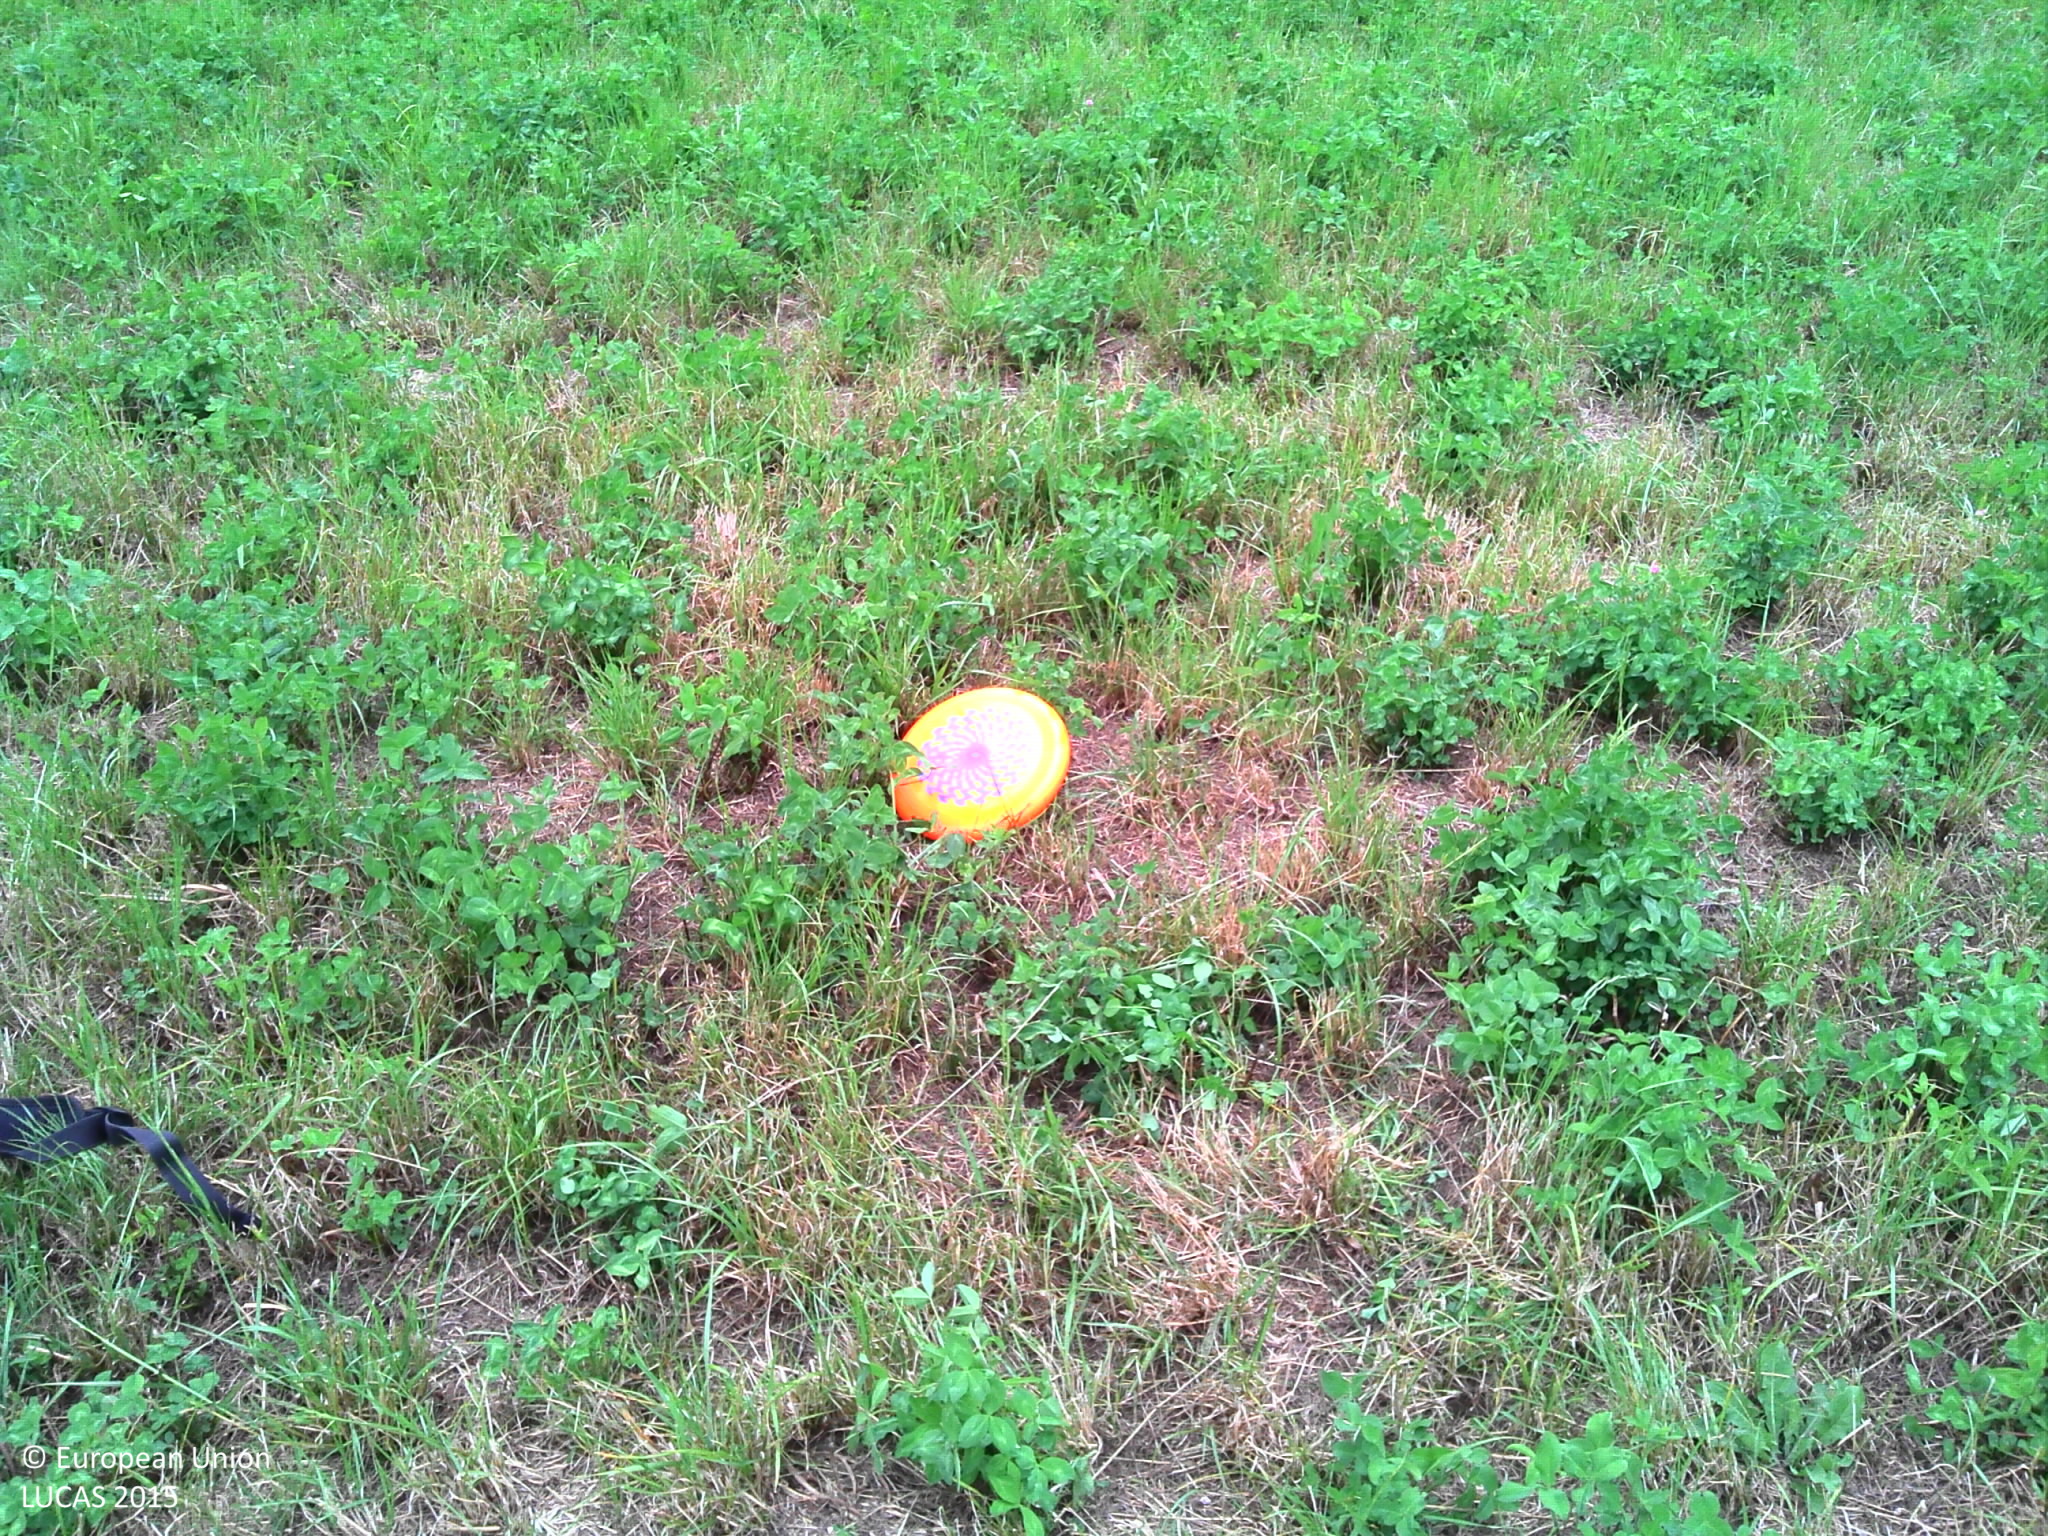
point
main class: Cropland
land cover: Temporary grasslands
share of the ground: > 75 %
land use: Agriculture (excluding fallow land and kitchen gardens)
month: July
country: FR
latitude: 47.8441
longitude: -3.2058
